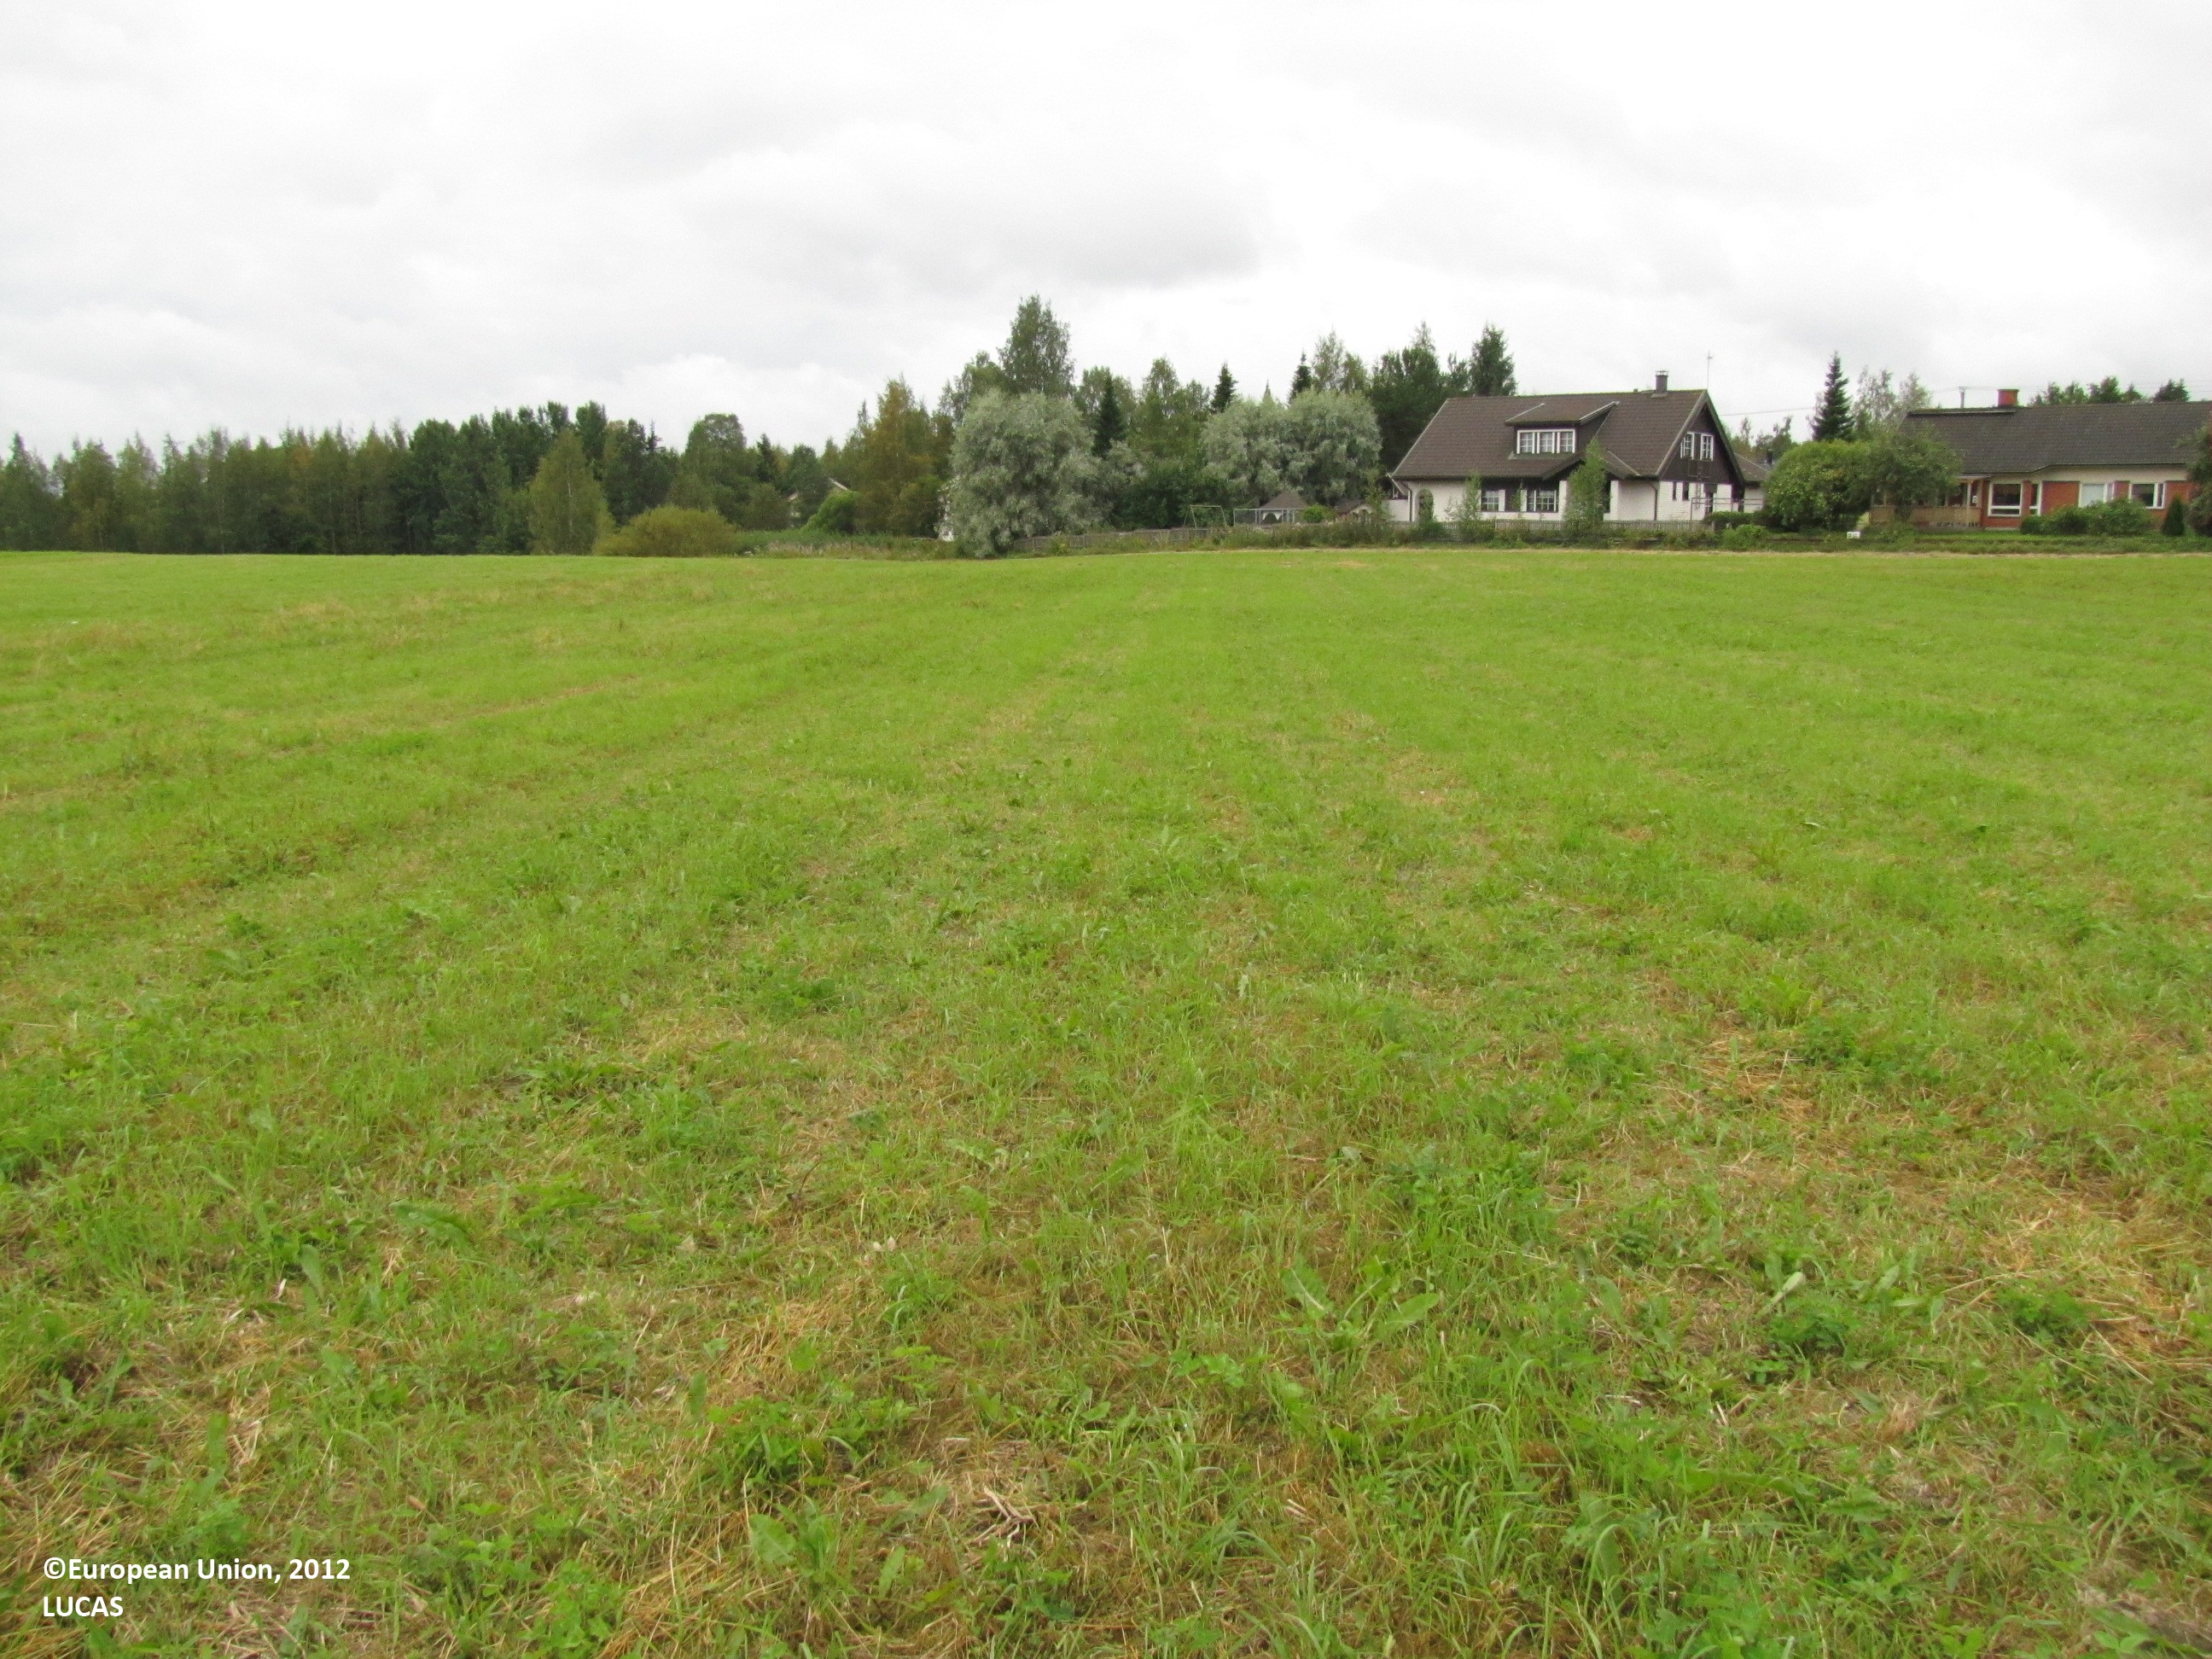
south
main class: Cropland
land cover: Temporary grasslands
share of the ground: > 75 %
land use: Agriculture (excluding fallow land and kitchen gardens)
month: August
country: FI
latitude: 61.5469
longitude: 23.6473
